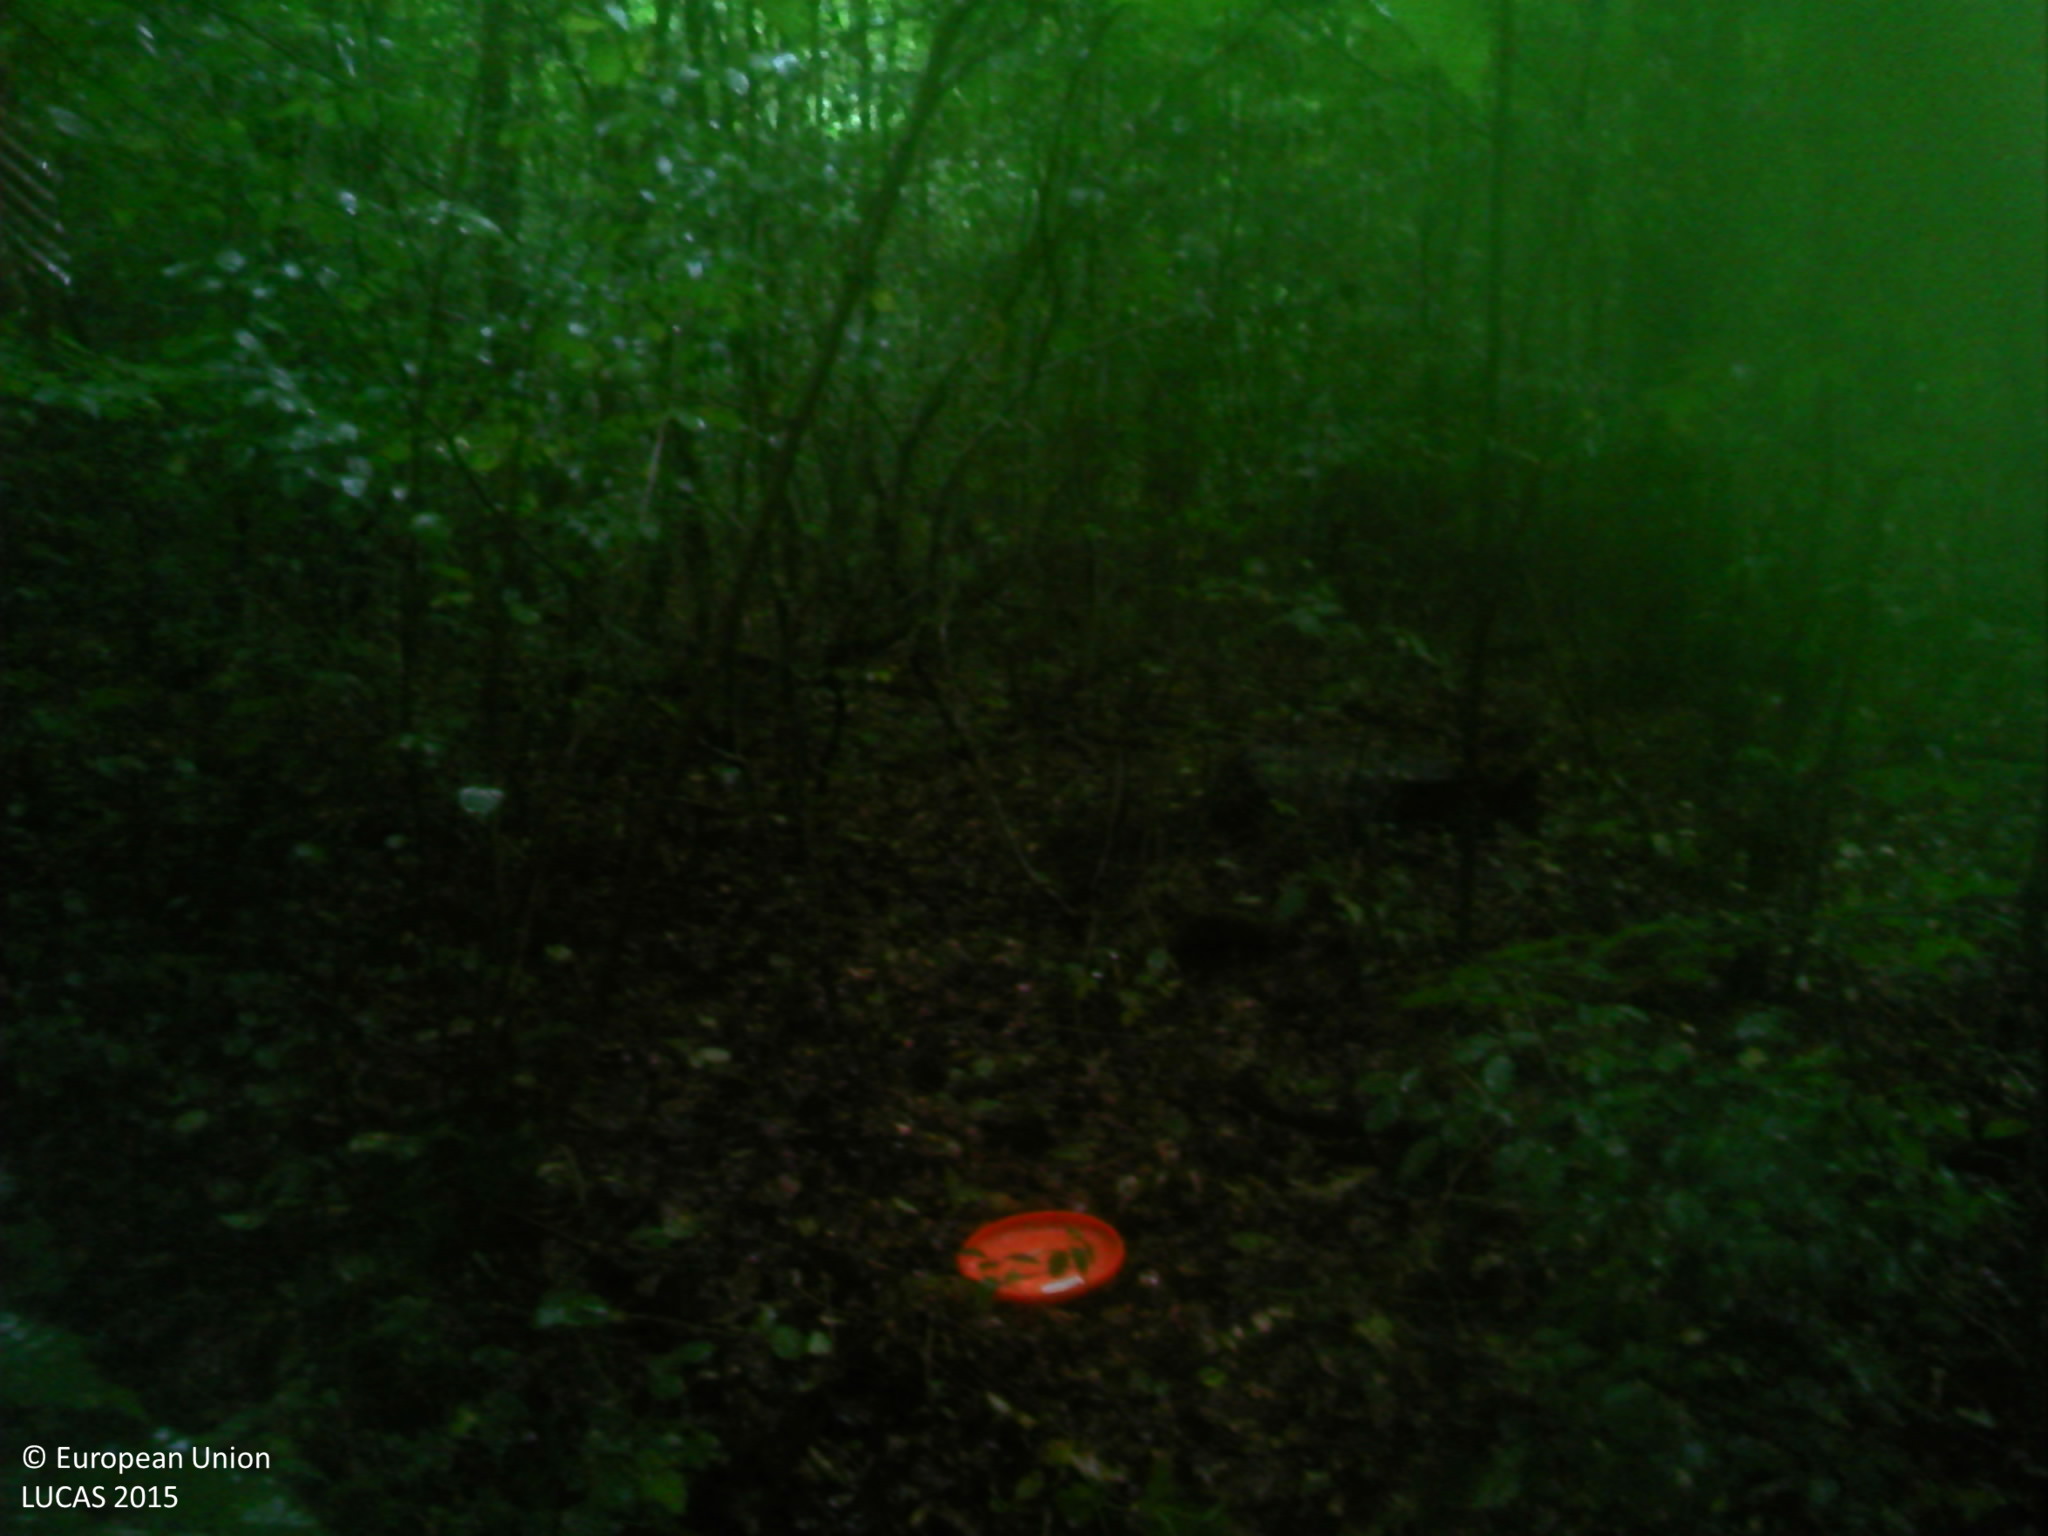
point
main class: Woodland
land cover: Broadleaved woodland
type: mesophytic deciduous forest
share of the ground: > 75 %
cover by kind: broadleaved forest trees 100 %
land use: Forestry
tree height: > 5 m
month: July
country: BE
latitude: 50.1302
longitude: 4.6385
